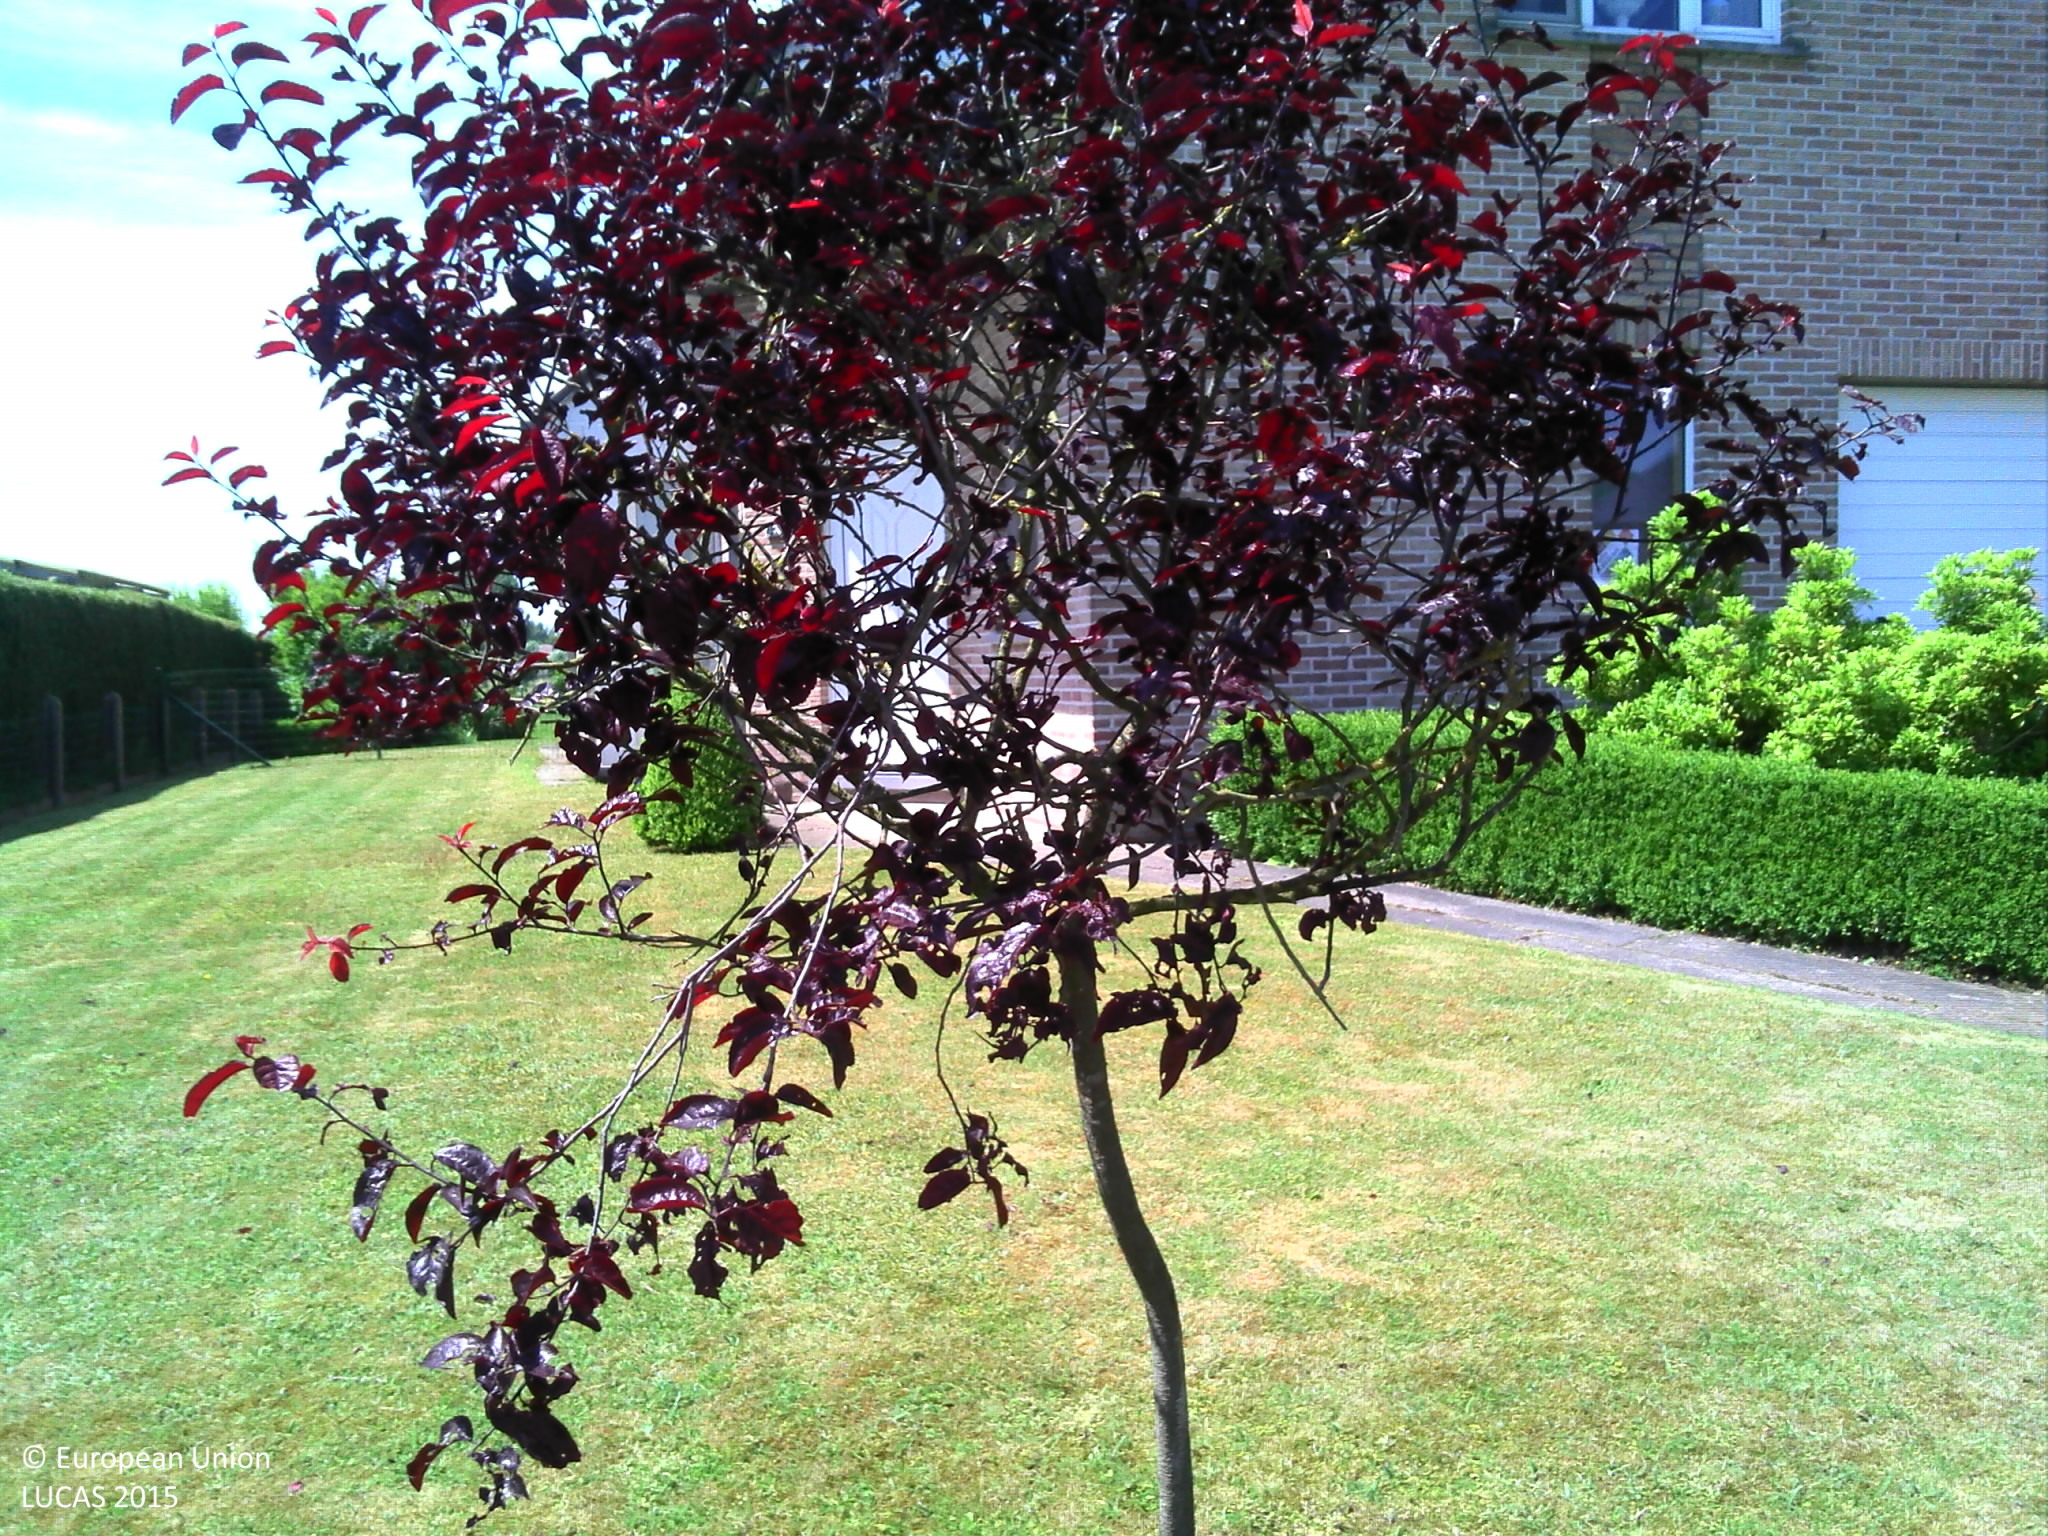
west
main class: Grassland
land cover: Grassland with sparse tree/shrub cover
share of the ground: > 75 %
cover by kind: herbaceous plants 95 %, broadleaved forest trees 5 %
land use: Residential
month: June
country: BE
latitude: 51.0592
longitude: 4.1018
